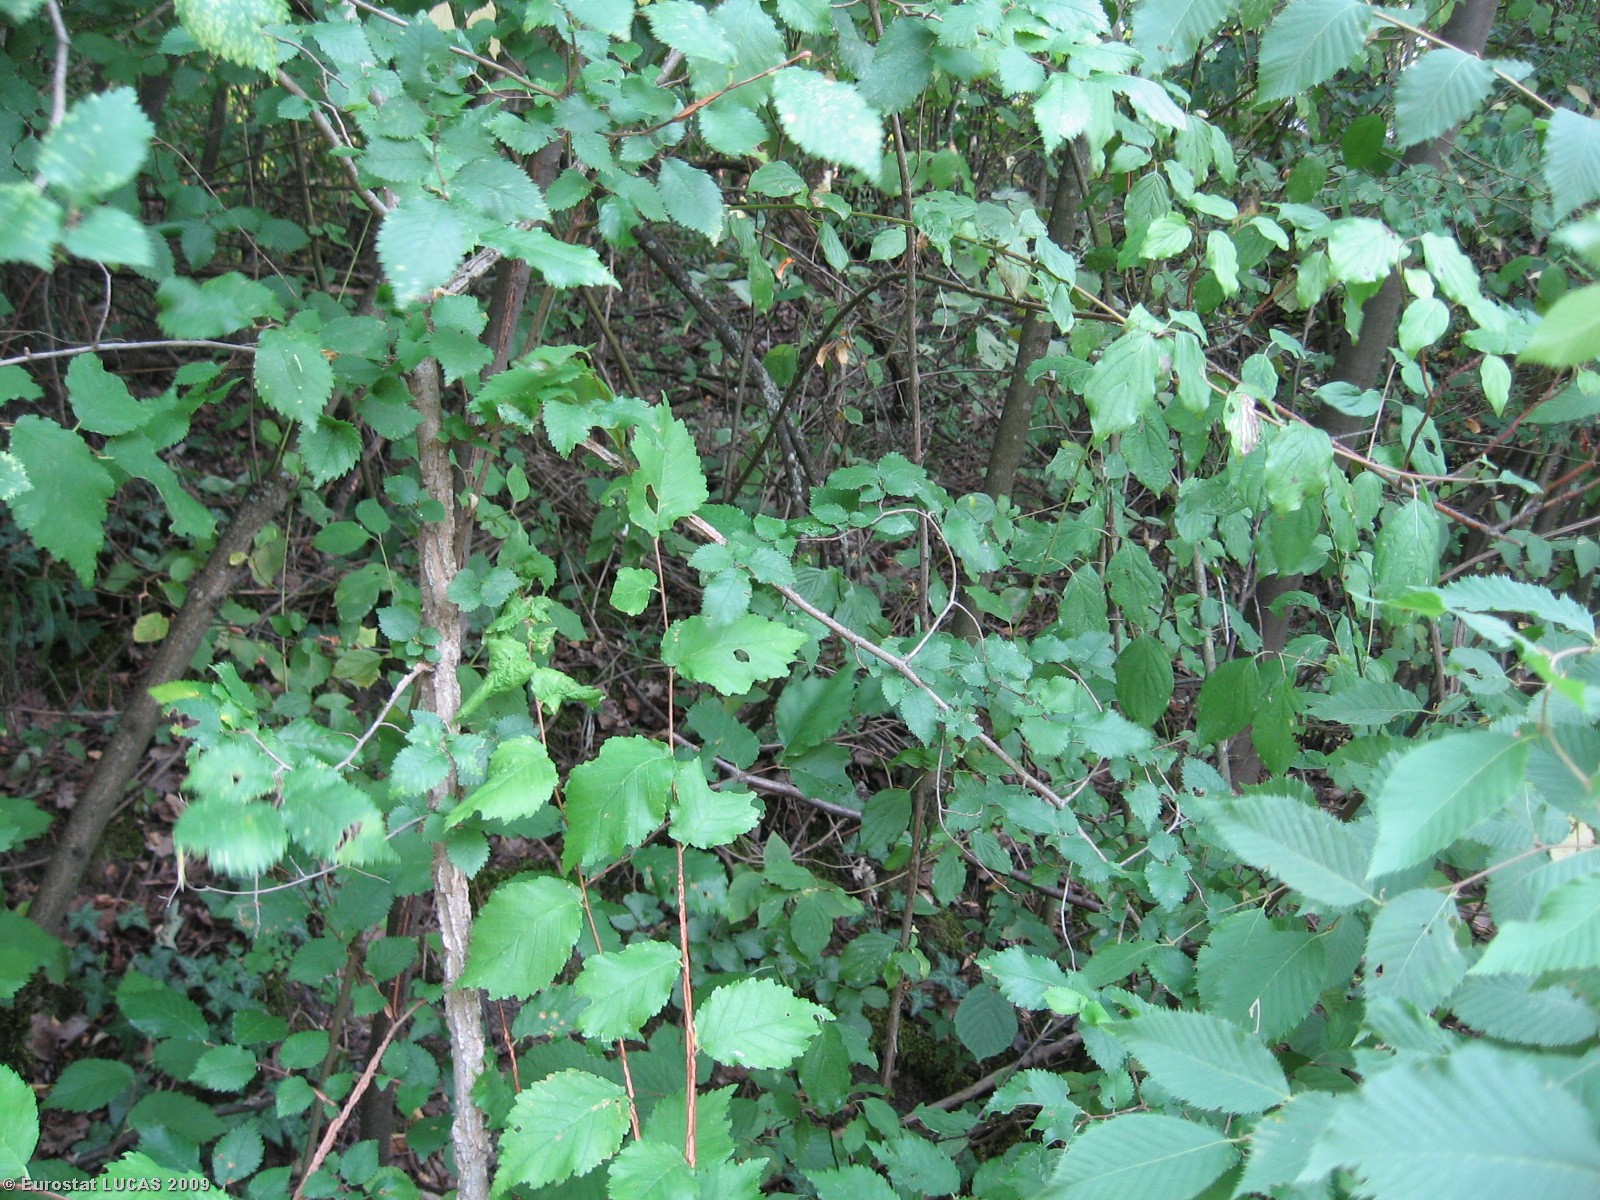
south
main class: Woodland
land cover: Broadleaved woodland
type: mesophytic deciduous forest
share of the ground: 50 - 75 %
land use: Forestry
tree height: > 5 m
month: July
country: IT
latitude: 44.8904
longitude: 9.5072
